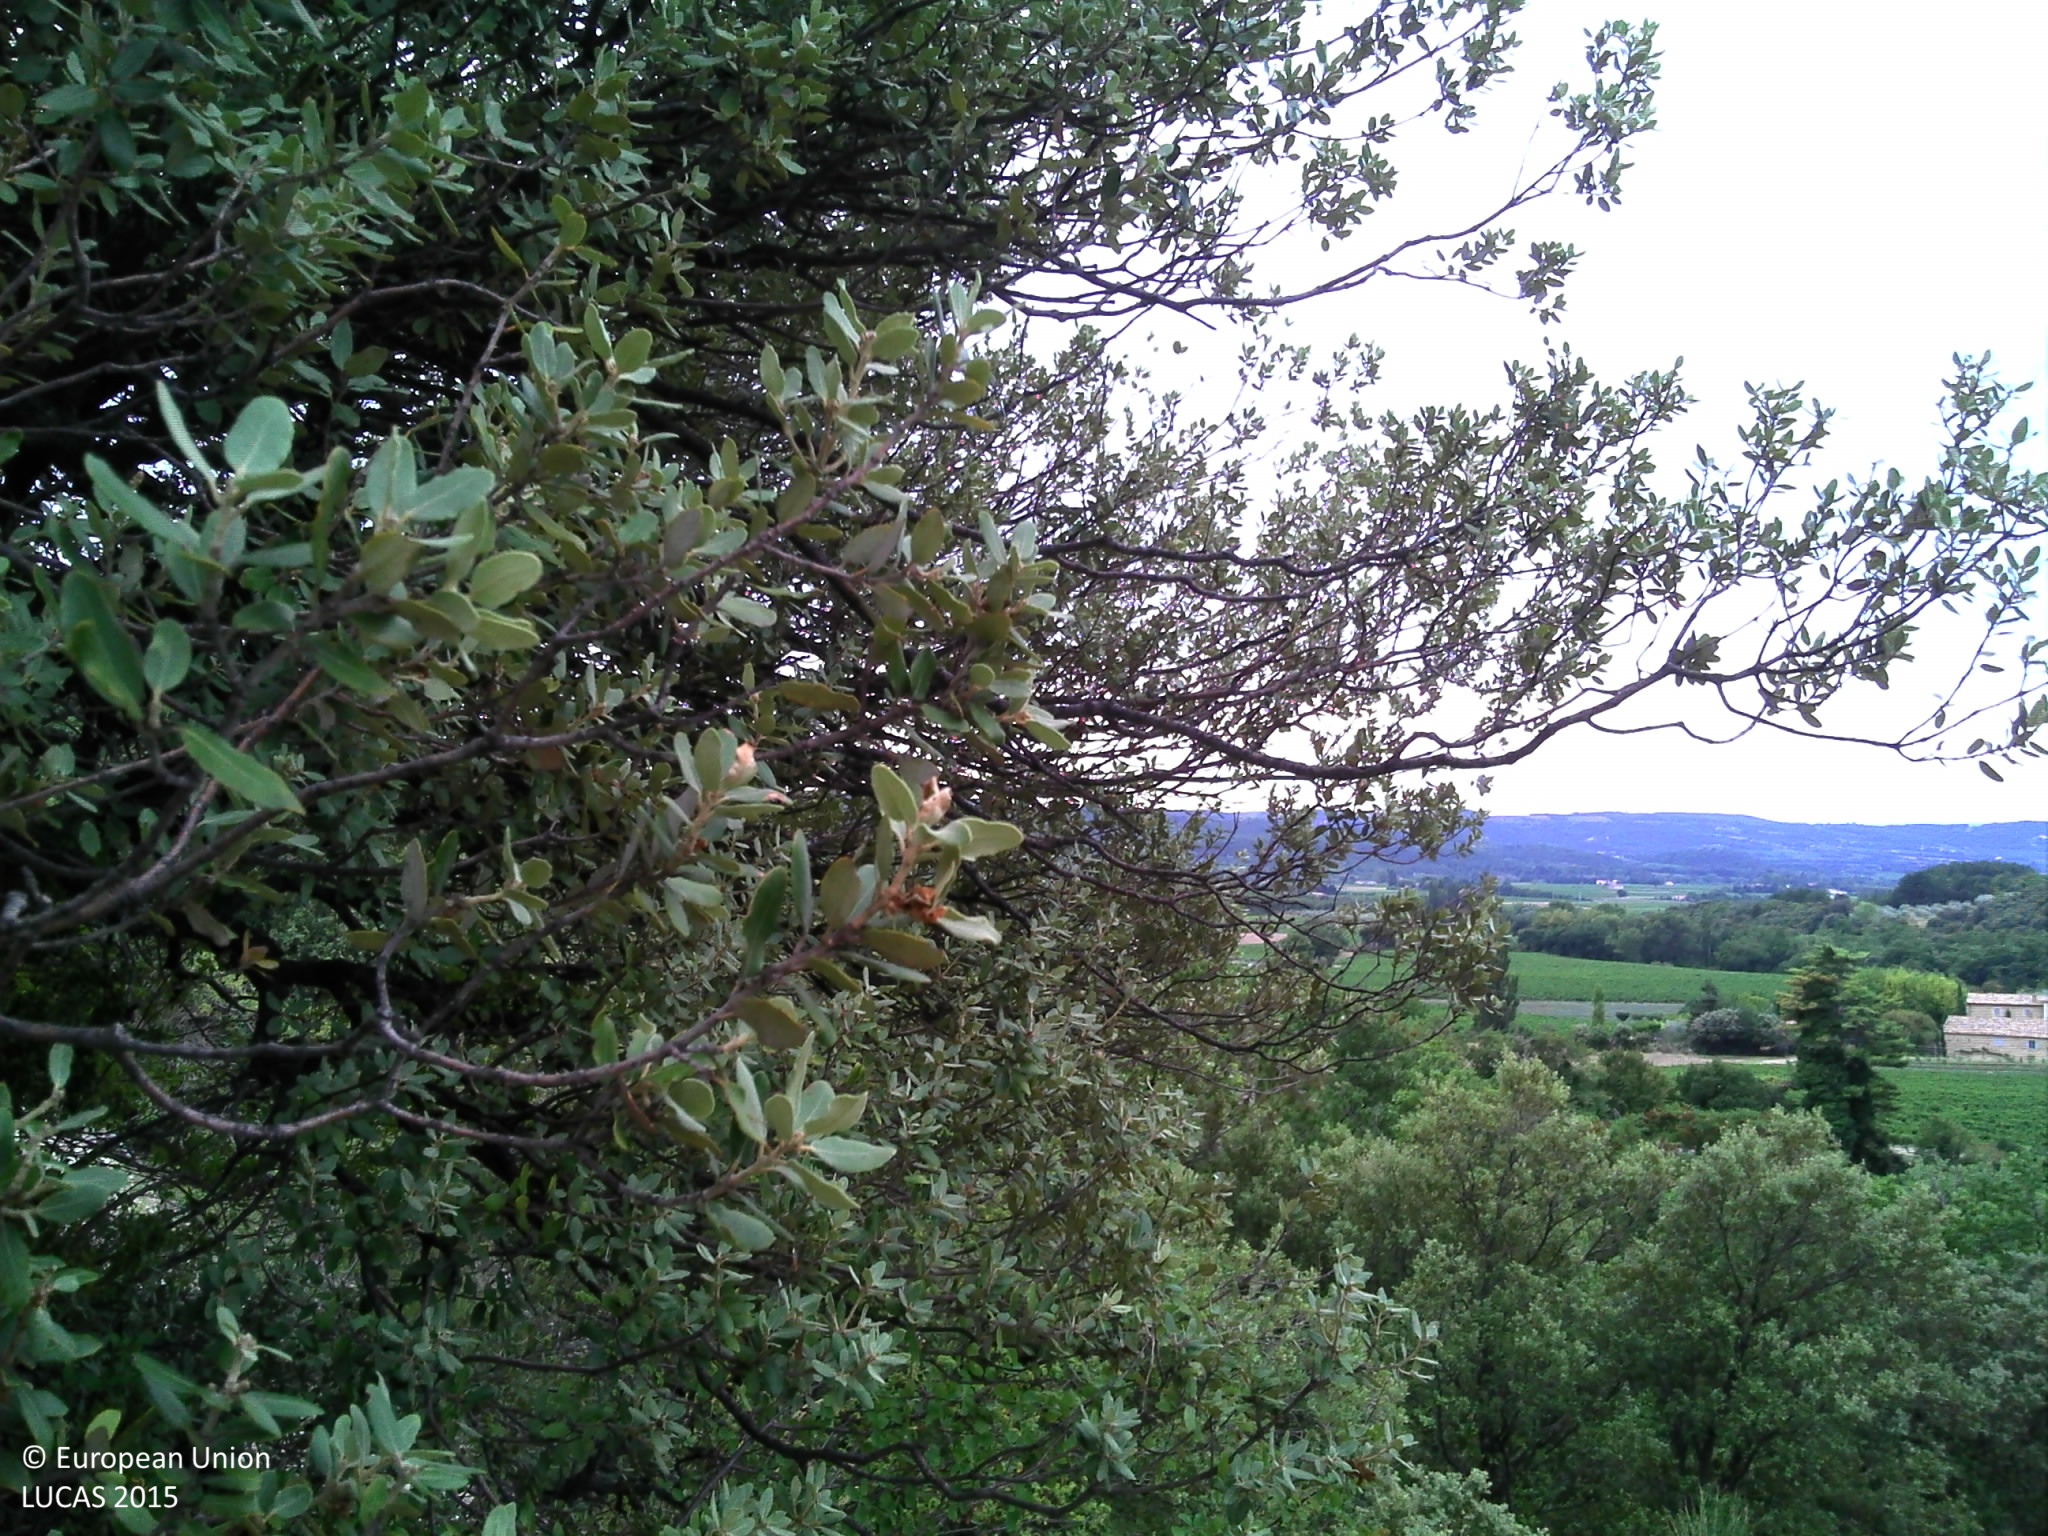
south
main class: Shrubland
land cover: Shrubland with sparse tree cover
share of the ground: > 75 %
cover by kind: shrubs 95 %, coniferous forest trees 5 %
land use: Semi-natural and natural areas not in use
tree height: < 5 m
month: September
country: FR
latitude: 44.4141
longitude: 5.0717
